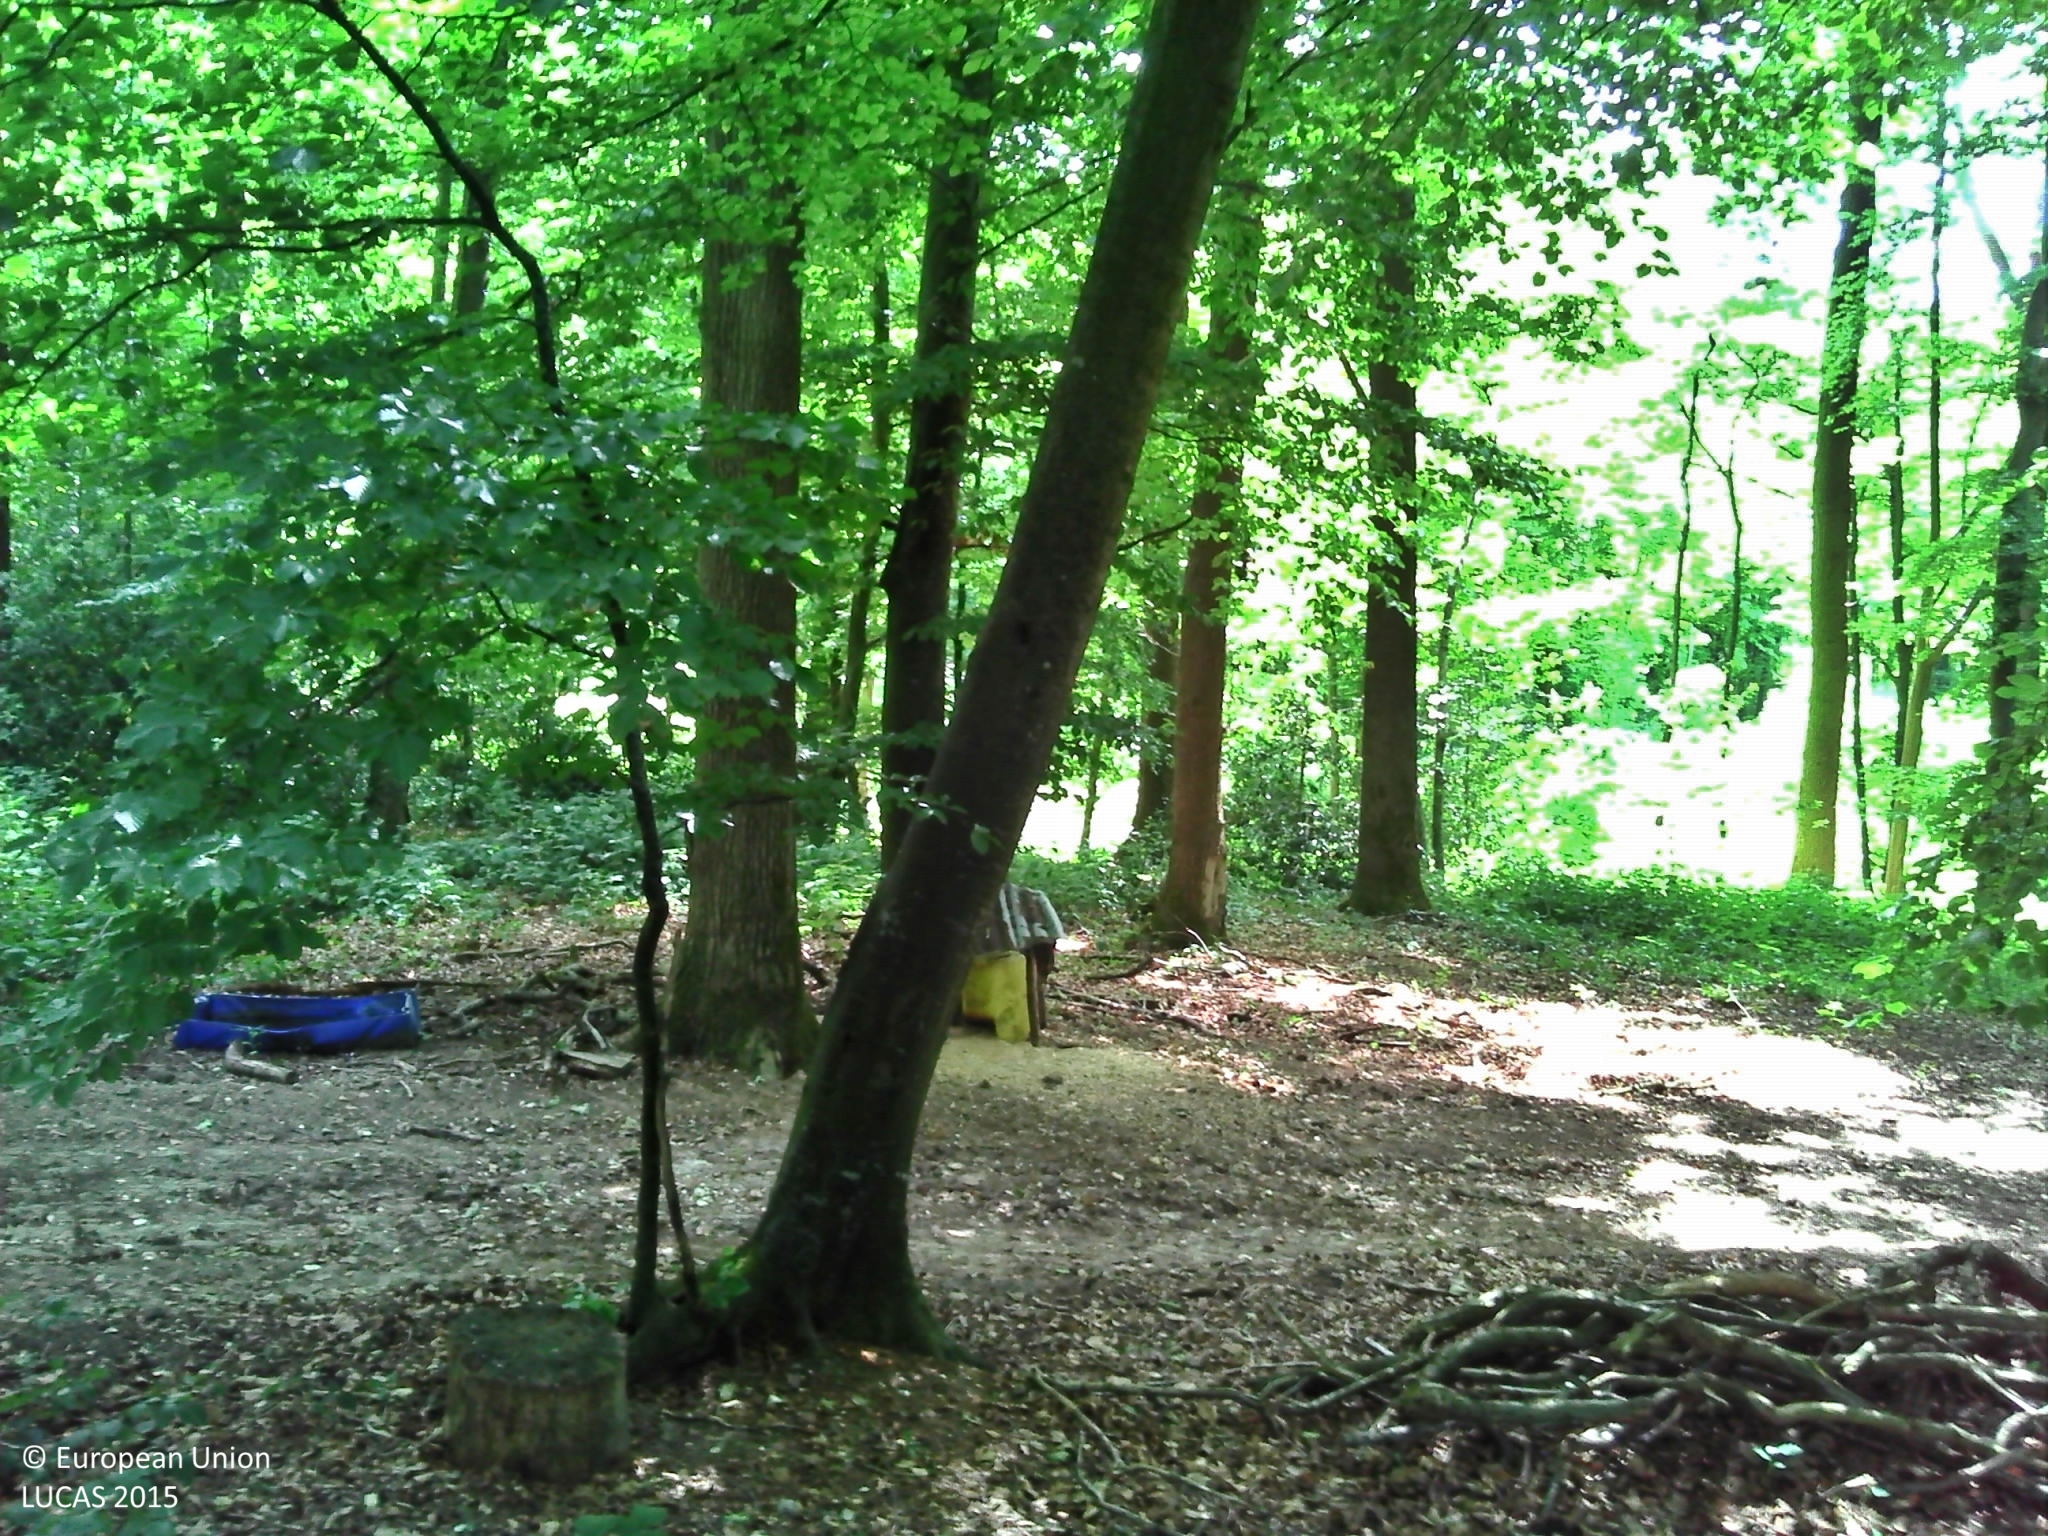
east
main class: Woodland
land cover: Broadleaved woodland
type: beech forest
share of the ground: > 75 %
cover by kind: broadleaved forest trees 80 %, herbaceous plants 15 %, shrubs 5 %
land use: Forestry
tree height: > 5 m
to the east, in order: Broadleaved woodland; Tracks; Broadleaved woodland; Groves; Maize; Grass margins; Common wheat
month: June
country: FR
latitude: 49.5218
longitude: 2.2367
